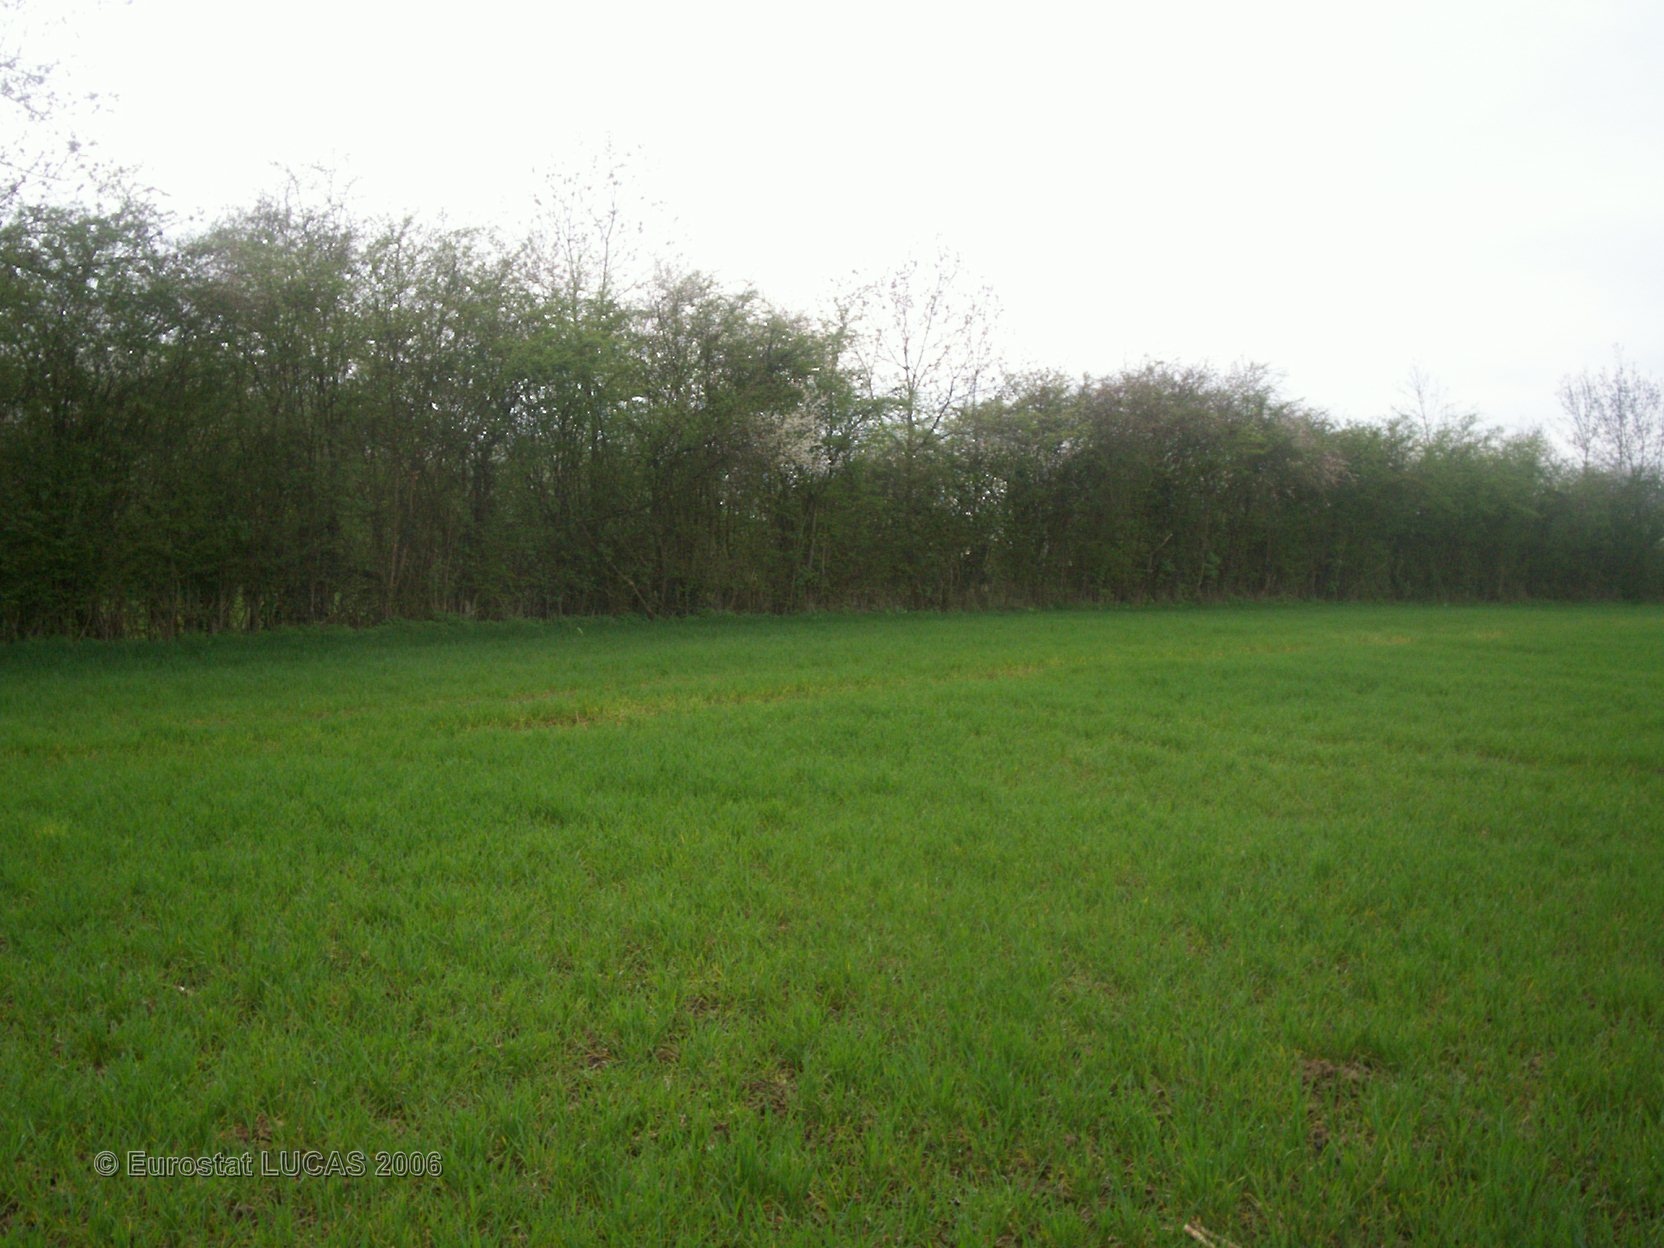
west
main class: Cropland
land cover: Common wheat
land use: Agriculture (excluding fallow land and kitchen gardens)
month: April
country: FR
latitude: 50.1952
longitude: 3.7880
